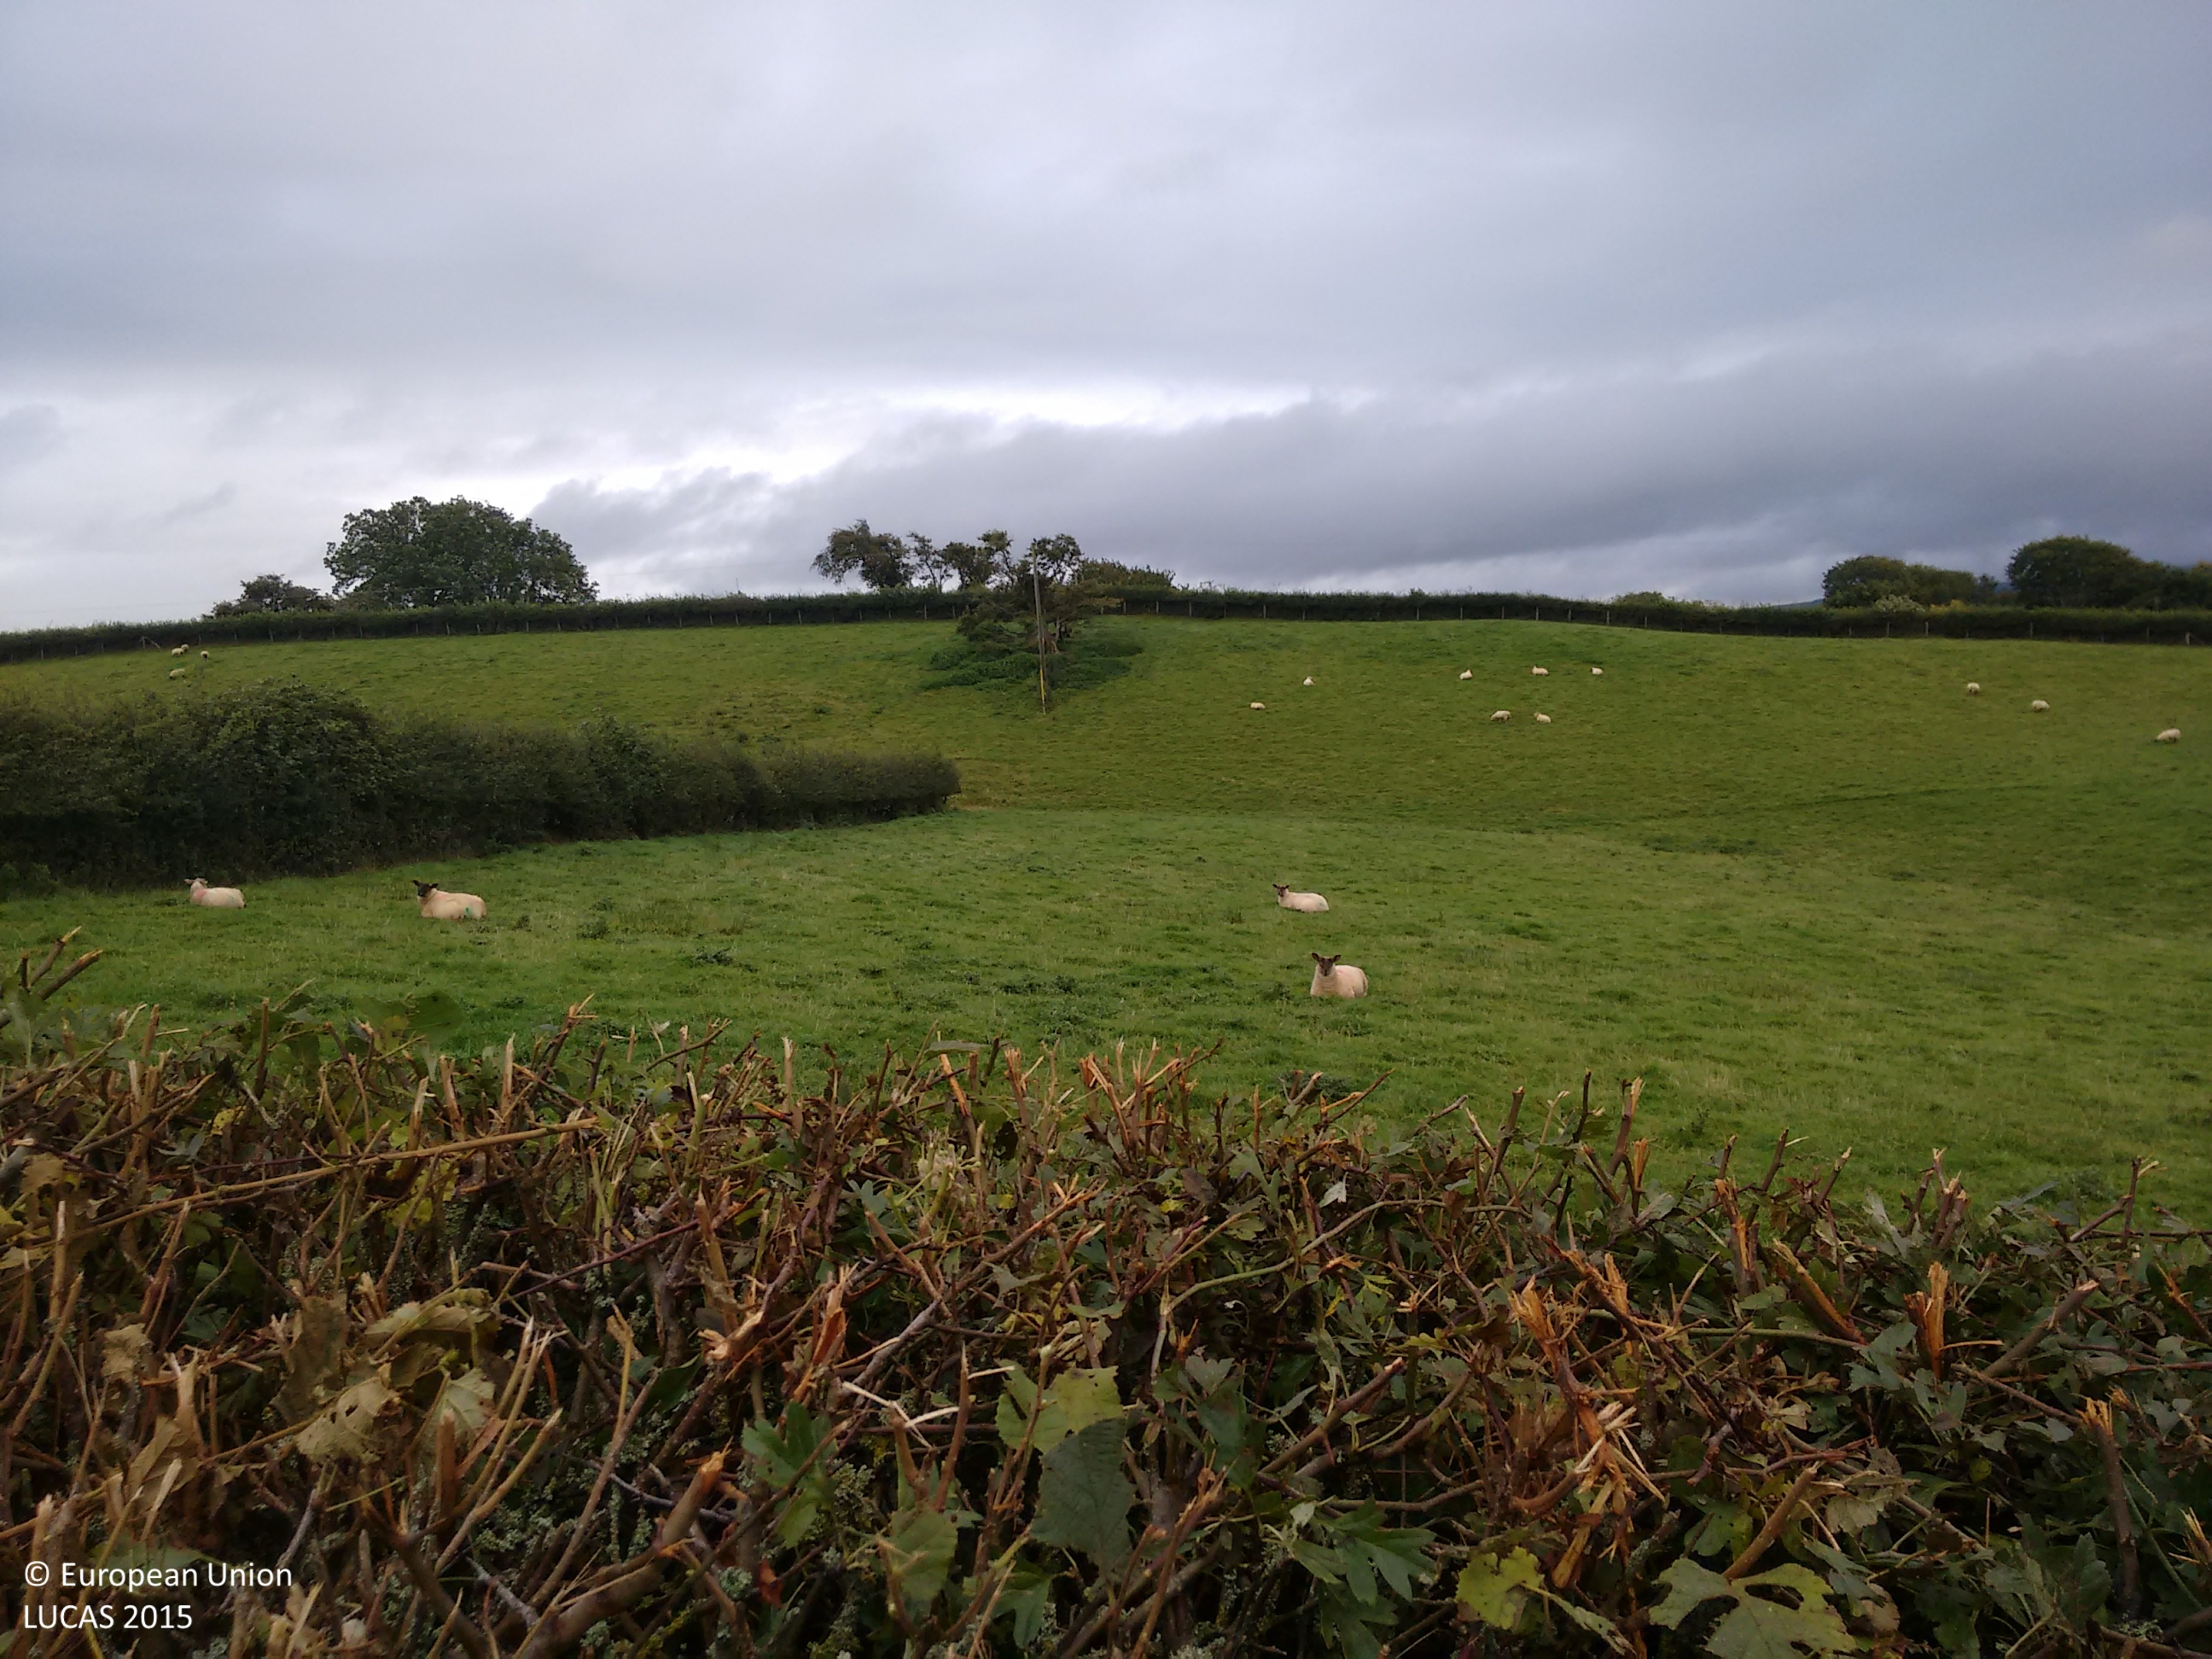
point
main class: Grassland
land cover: Grassland with sparse tree/shrub cover
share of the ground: > 75 %
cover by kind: herbaceous plants 95 %, broadleaved forest trees 5 %
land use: Agriculture (excluding fallow land and kitchen gardens)
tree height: > 5 m
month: September
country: GB
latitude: 52.5358
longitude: -3.3049
